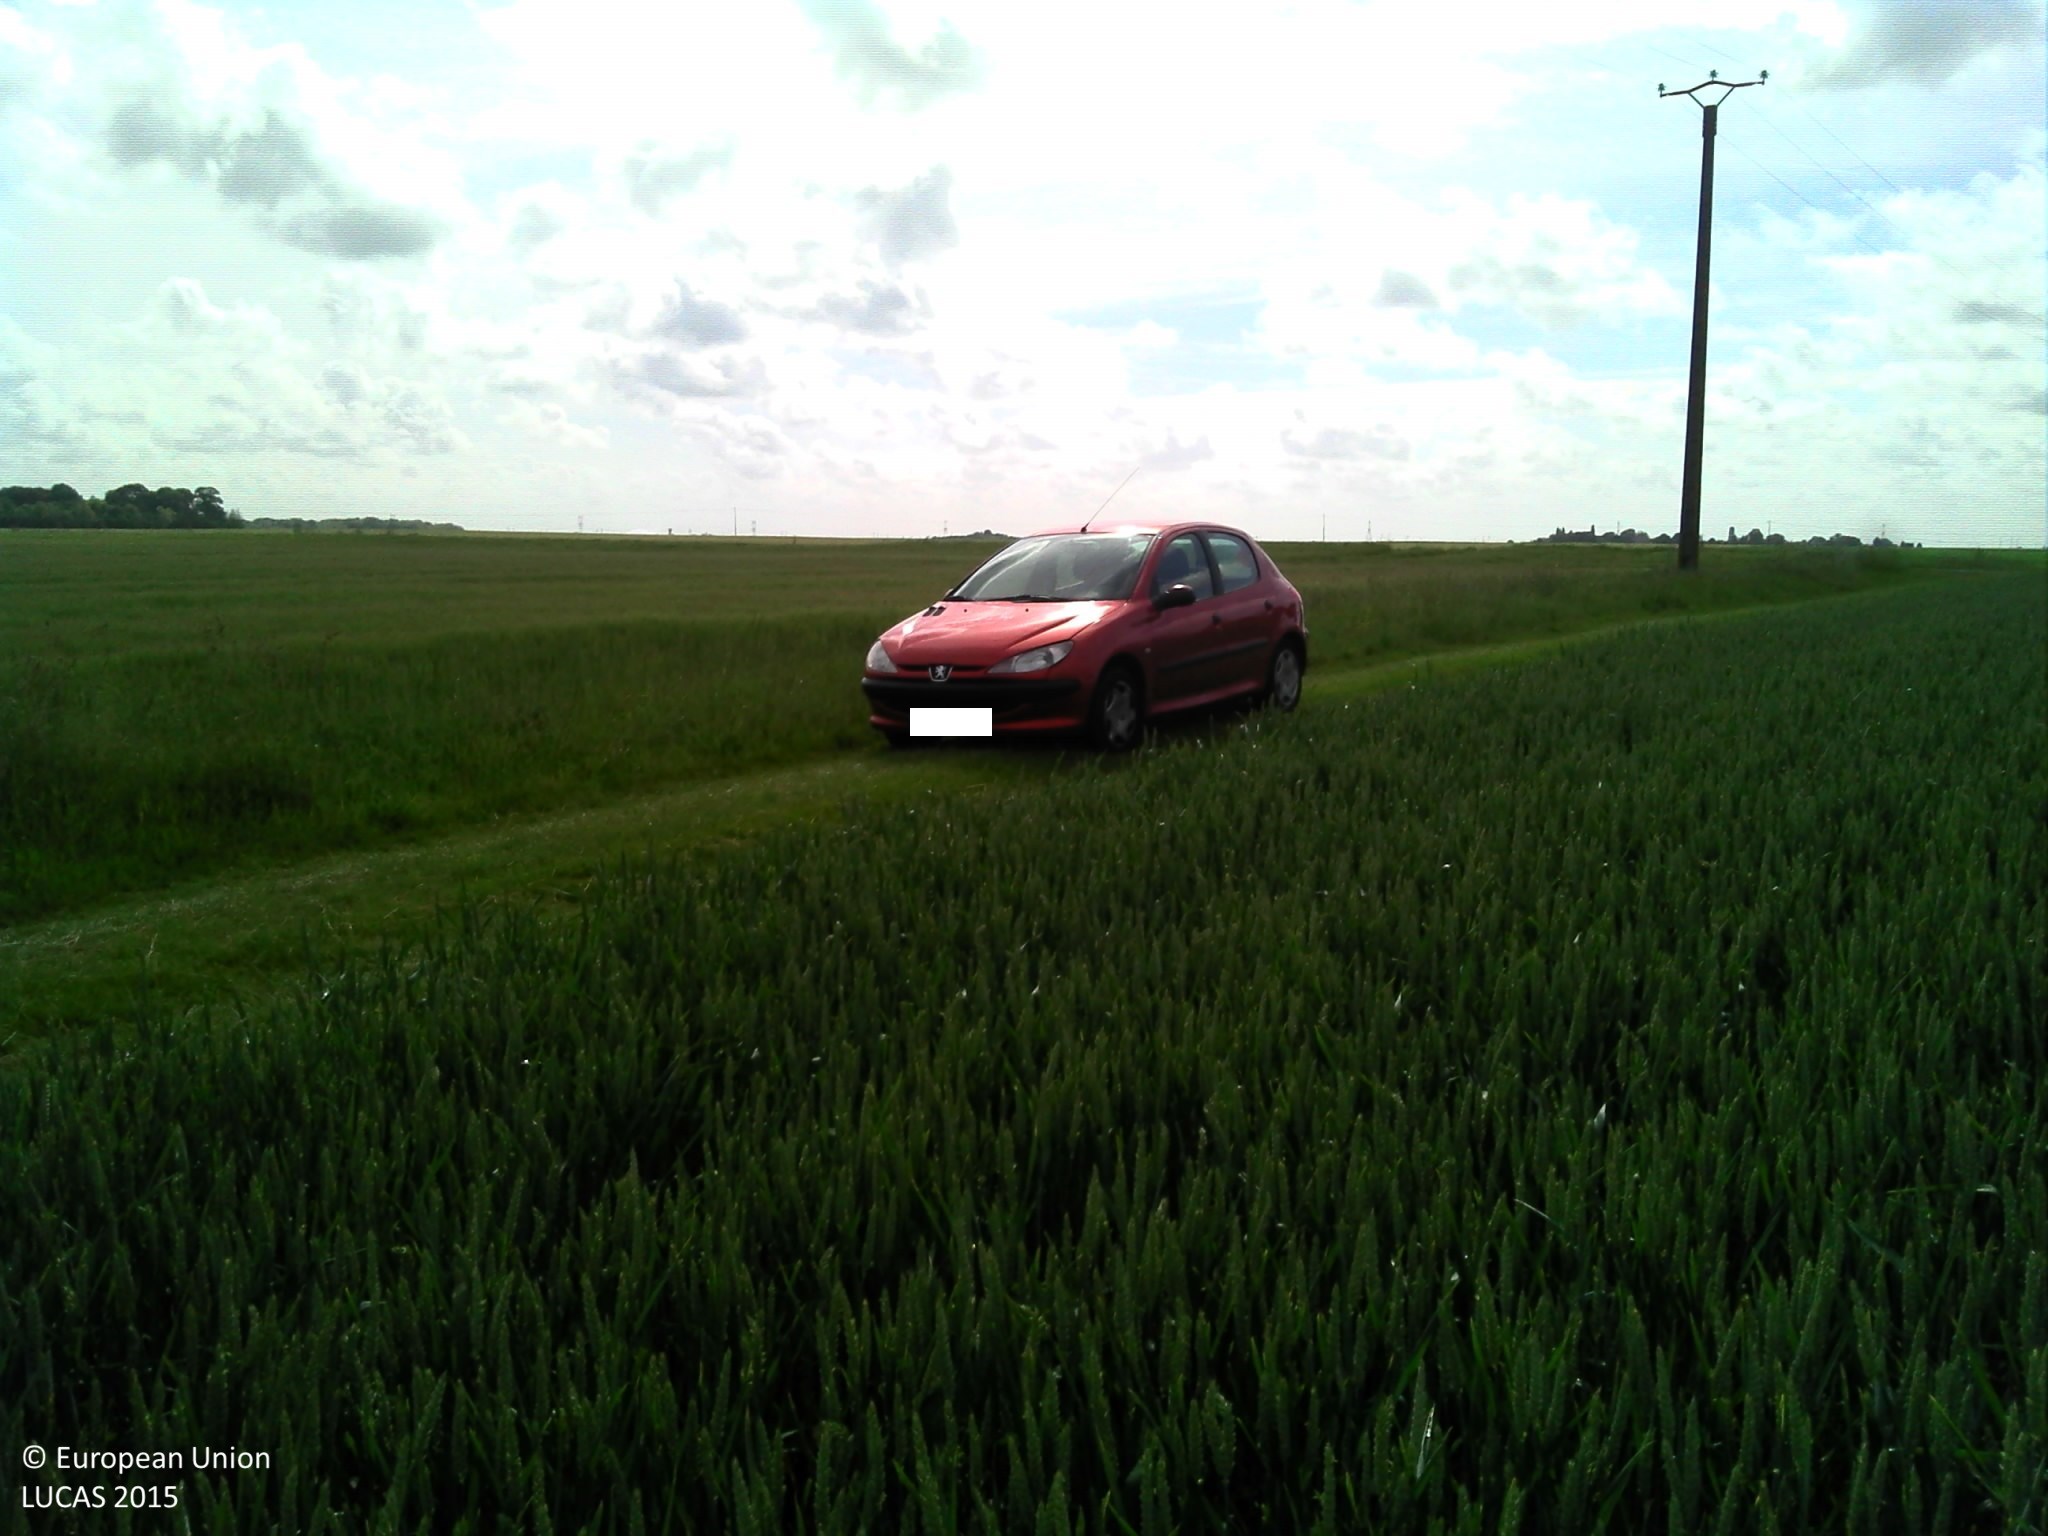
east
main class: Cropland
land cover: Common wheat
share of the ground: > 75 %
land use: Agriculture (excluding fallow land and kitchen gardens)
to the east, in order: Common wheat; Tracks; Grass margins; Electric lines; Barley; Grass margins; Paved roads, cycling and walking lanes; Grass margins; Sugar beet; Barley
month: June
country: FR
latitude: 48.3057
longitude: 1.9105
